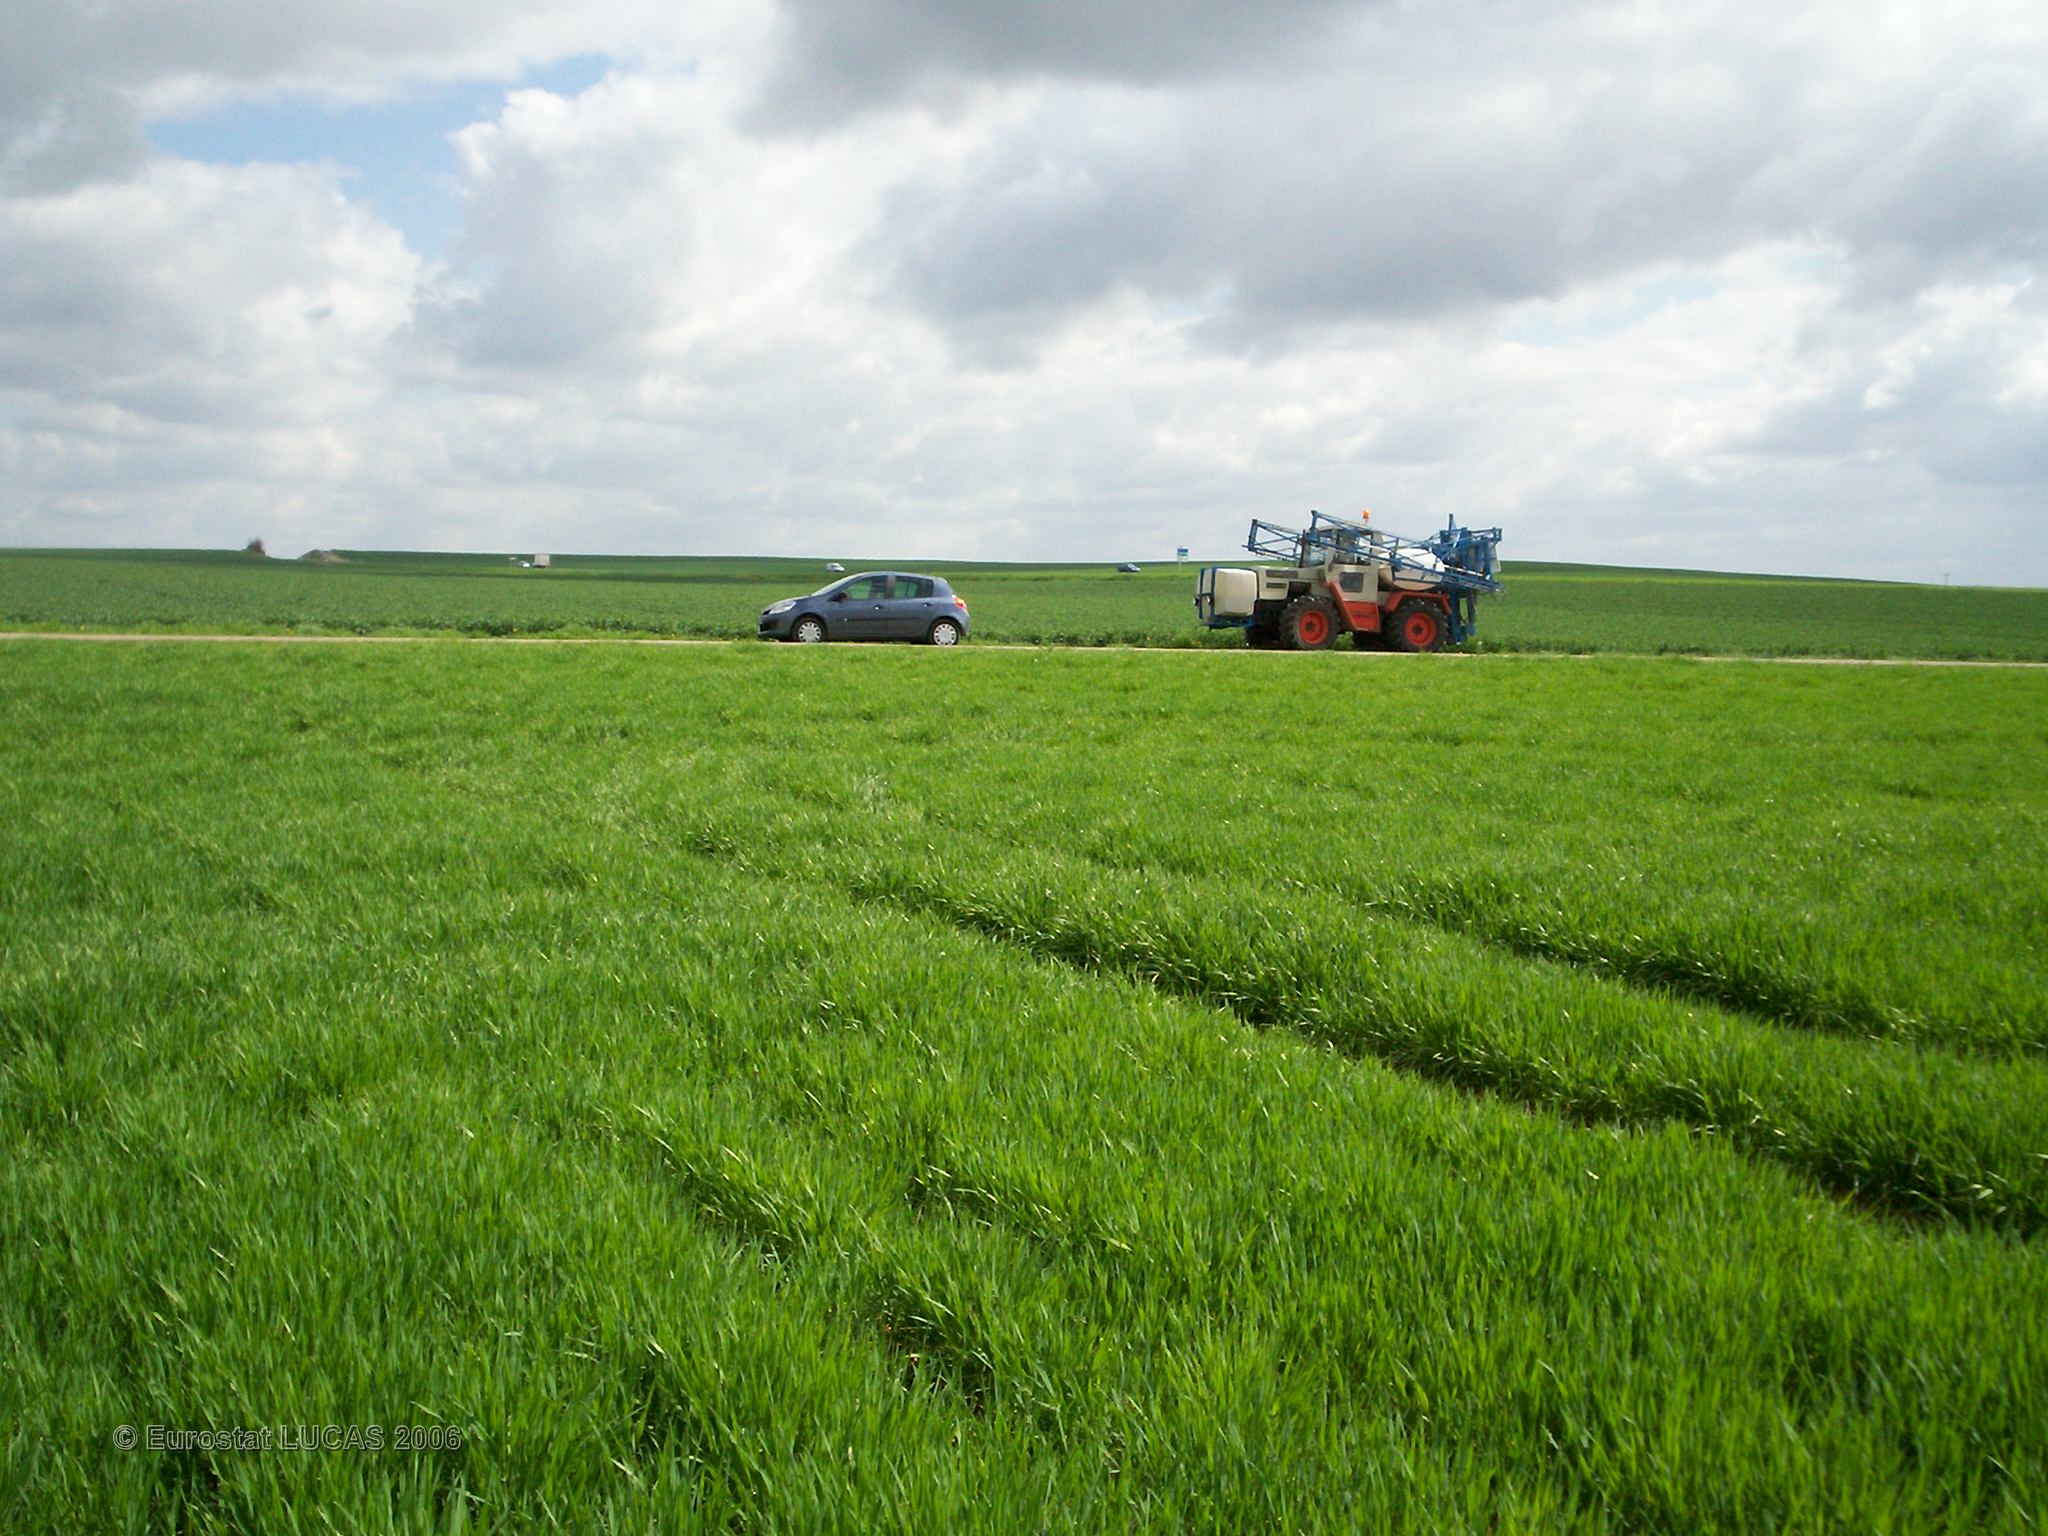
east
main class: Cropland
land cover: Barley
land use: Agriculture (excluding fallow land and kitchen gardens)
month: April
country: FR
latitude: 48.0676
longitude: 3.8093
